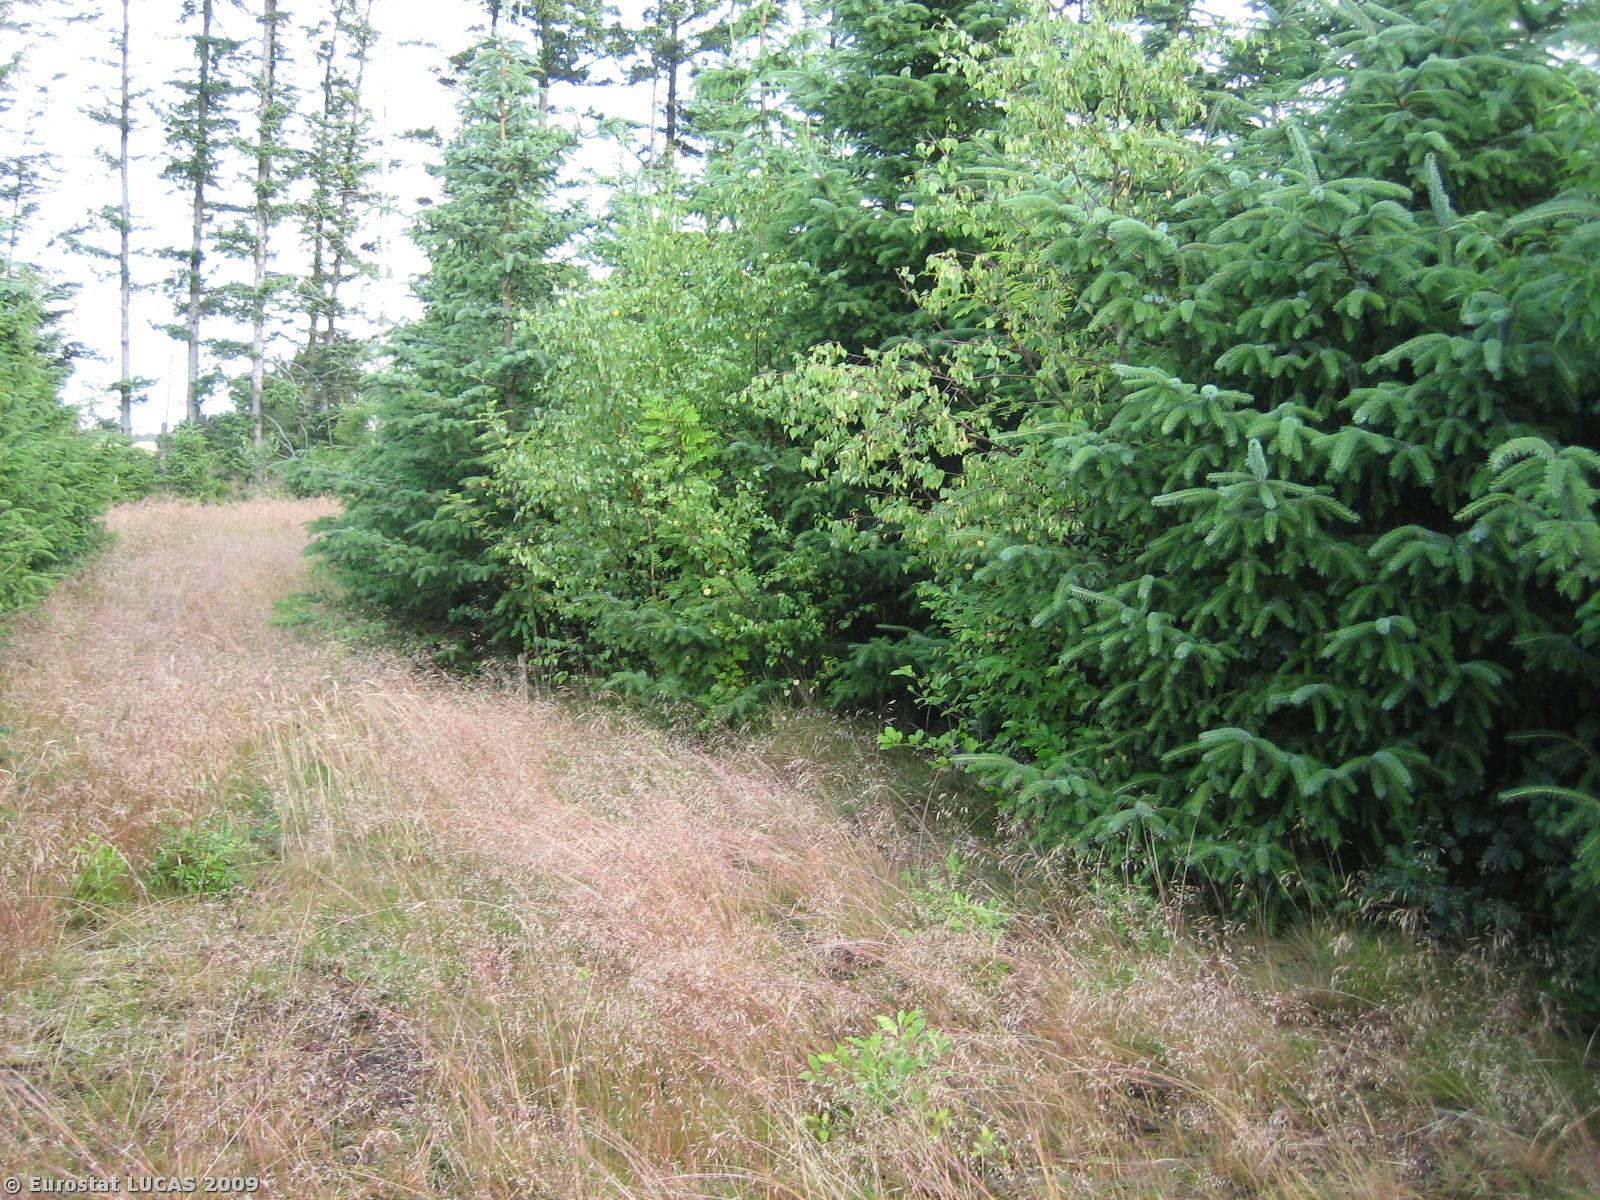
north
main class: Woodland
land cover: Coniferous woodland
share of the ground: > 75 %
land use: Forestry
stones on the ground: < 10 %
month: July
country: DK
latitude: 55.5653
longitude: 8.3048
